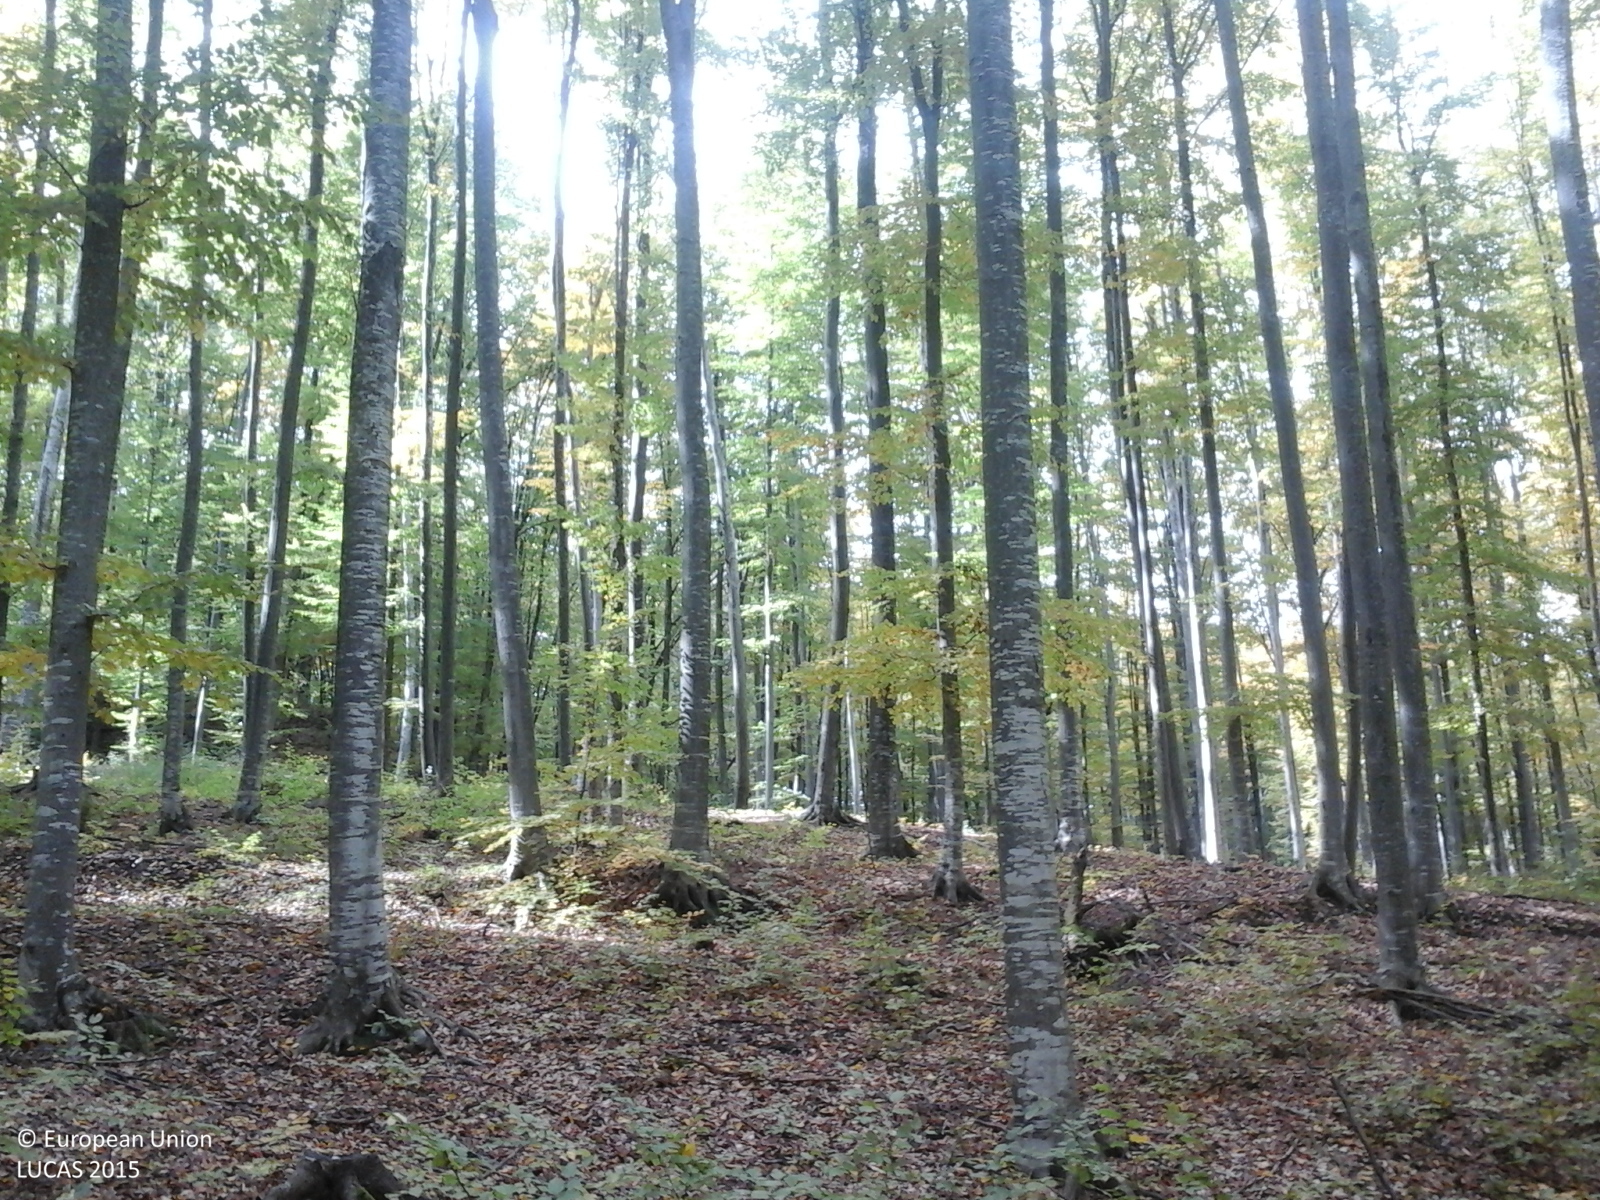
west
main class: Woodland
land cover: Broadleaved woodland
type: mesophytic deciduous forest
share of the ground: > 75 %
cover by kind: broadleaved forest trees 100 %
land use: Forestry
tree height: > 5 m
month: October
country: RO
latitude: 45.1762
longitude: 25.7426
